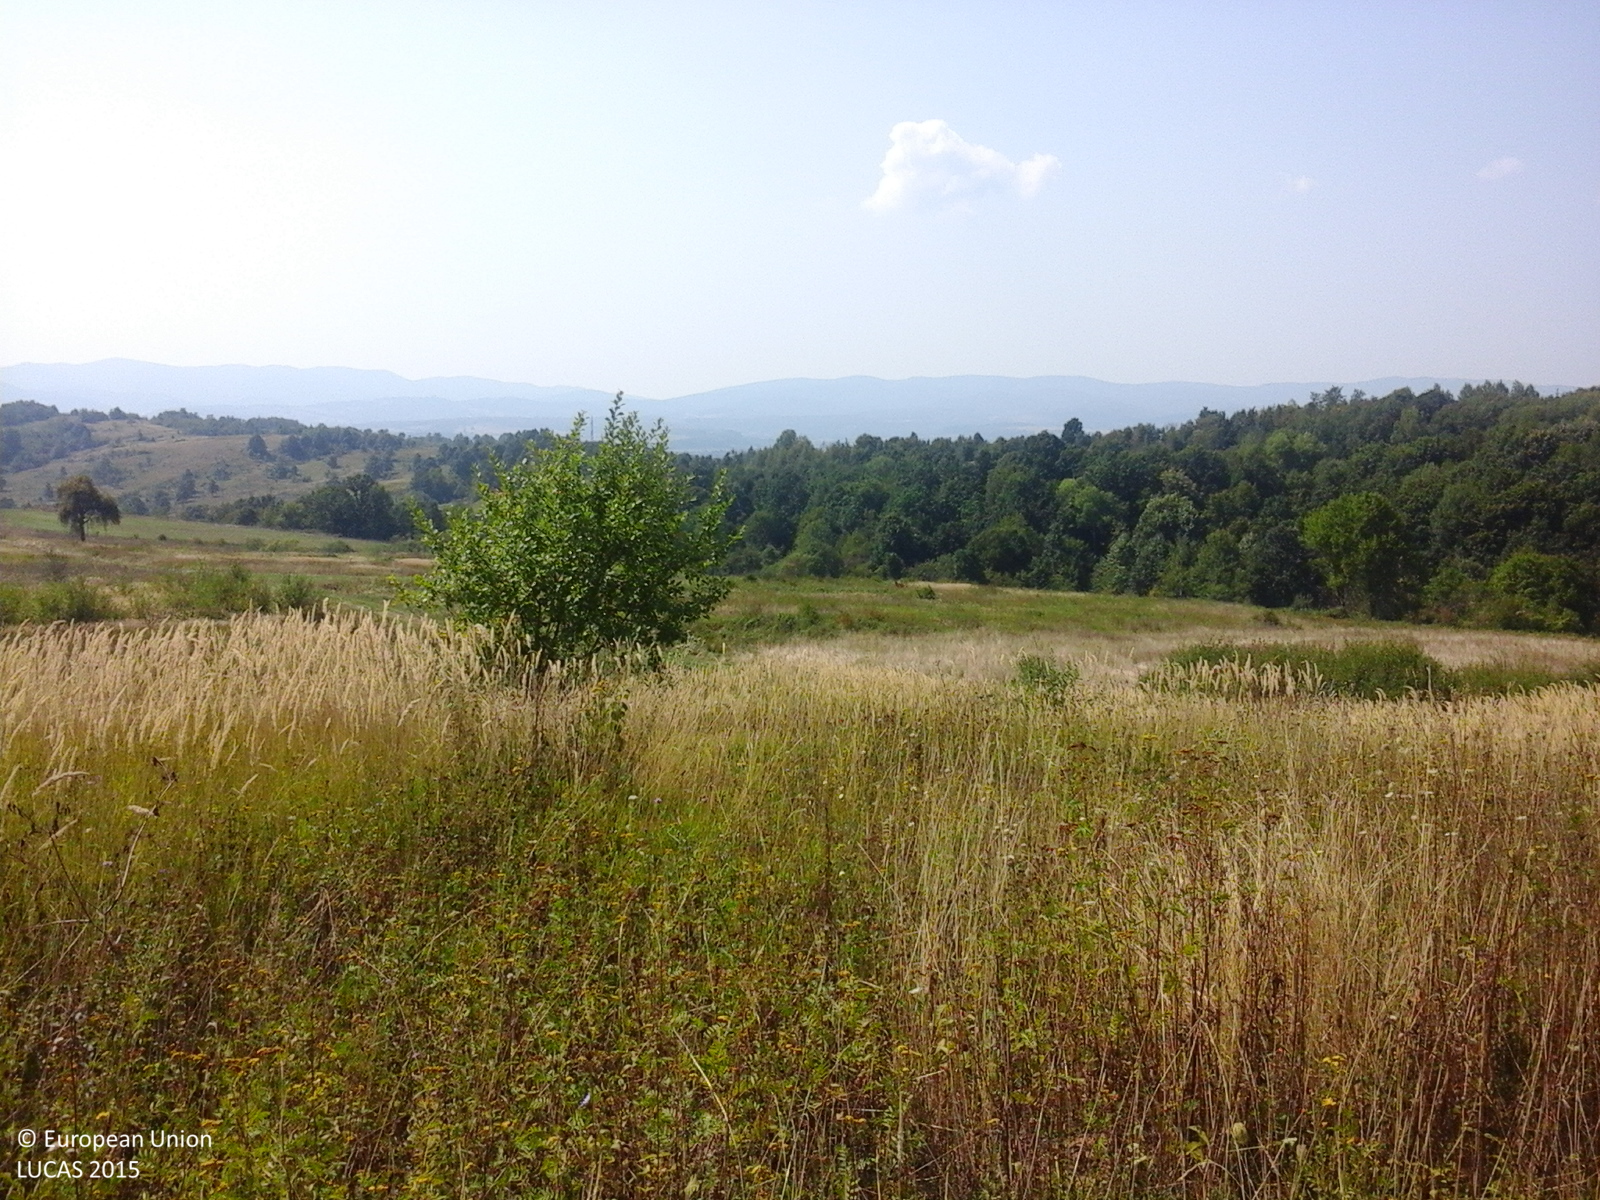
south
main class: Grassland
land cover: Grassland without tree/shrub cover
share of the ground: > 75 %
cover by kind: herbaceous plants 100 %
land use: Agriculture (excluding fallow land and kitchen gardens)
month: August
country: RO
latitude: 46.3069
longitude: 22.3443
